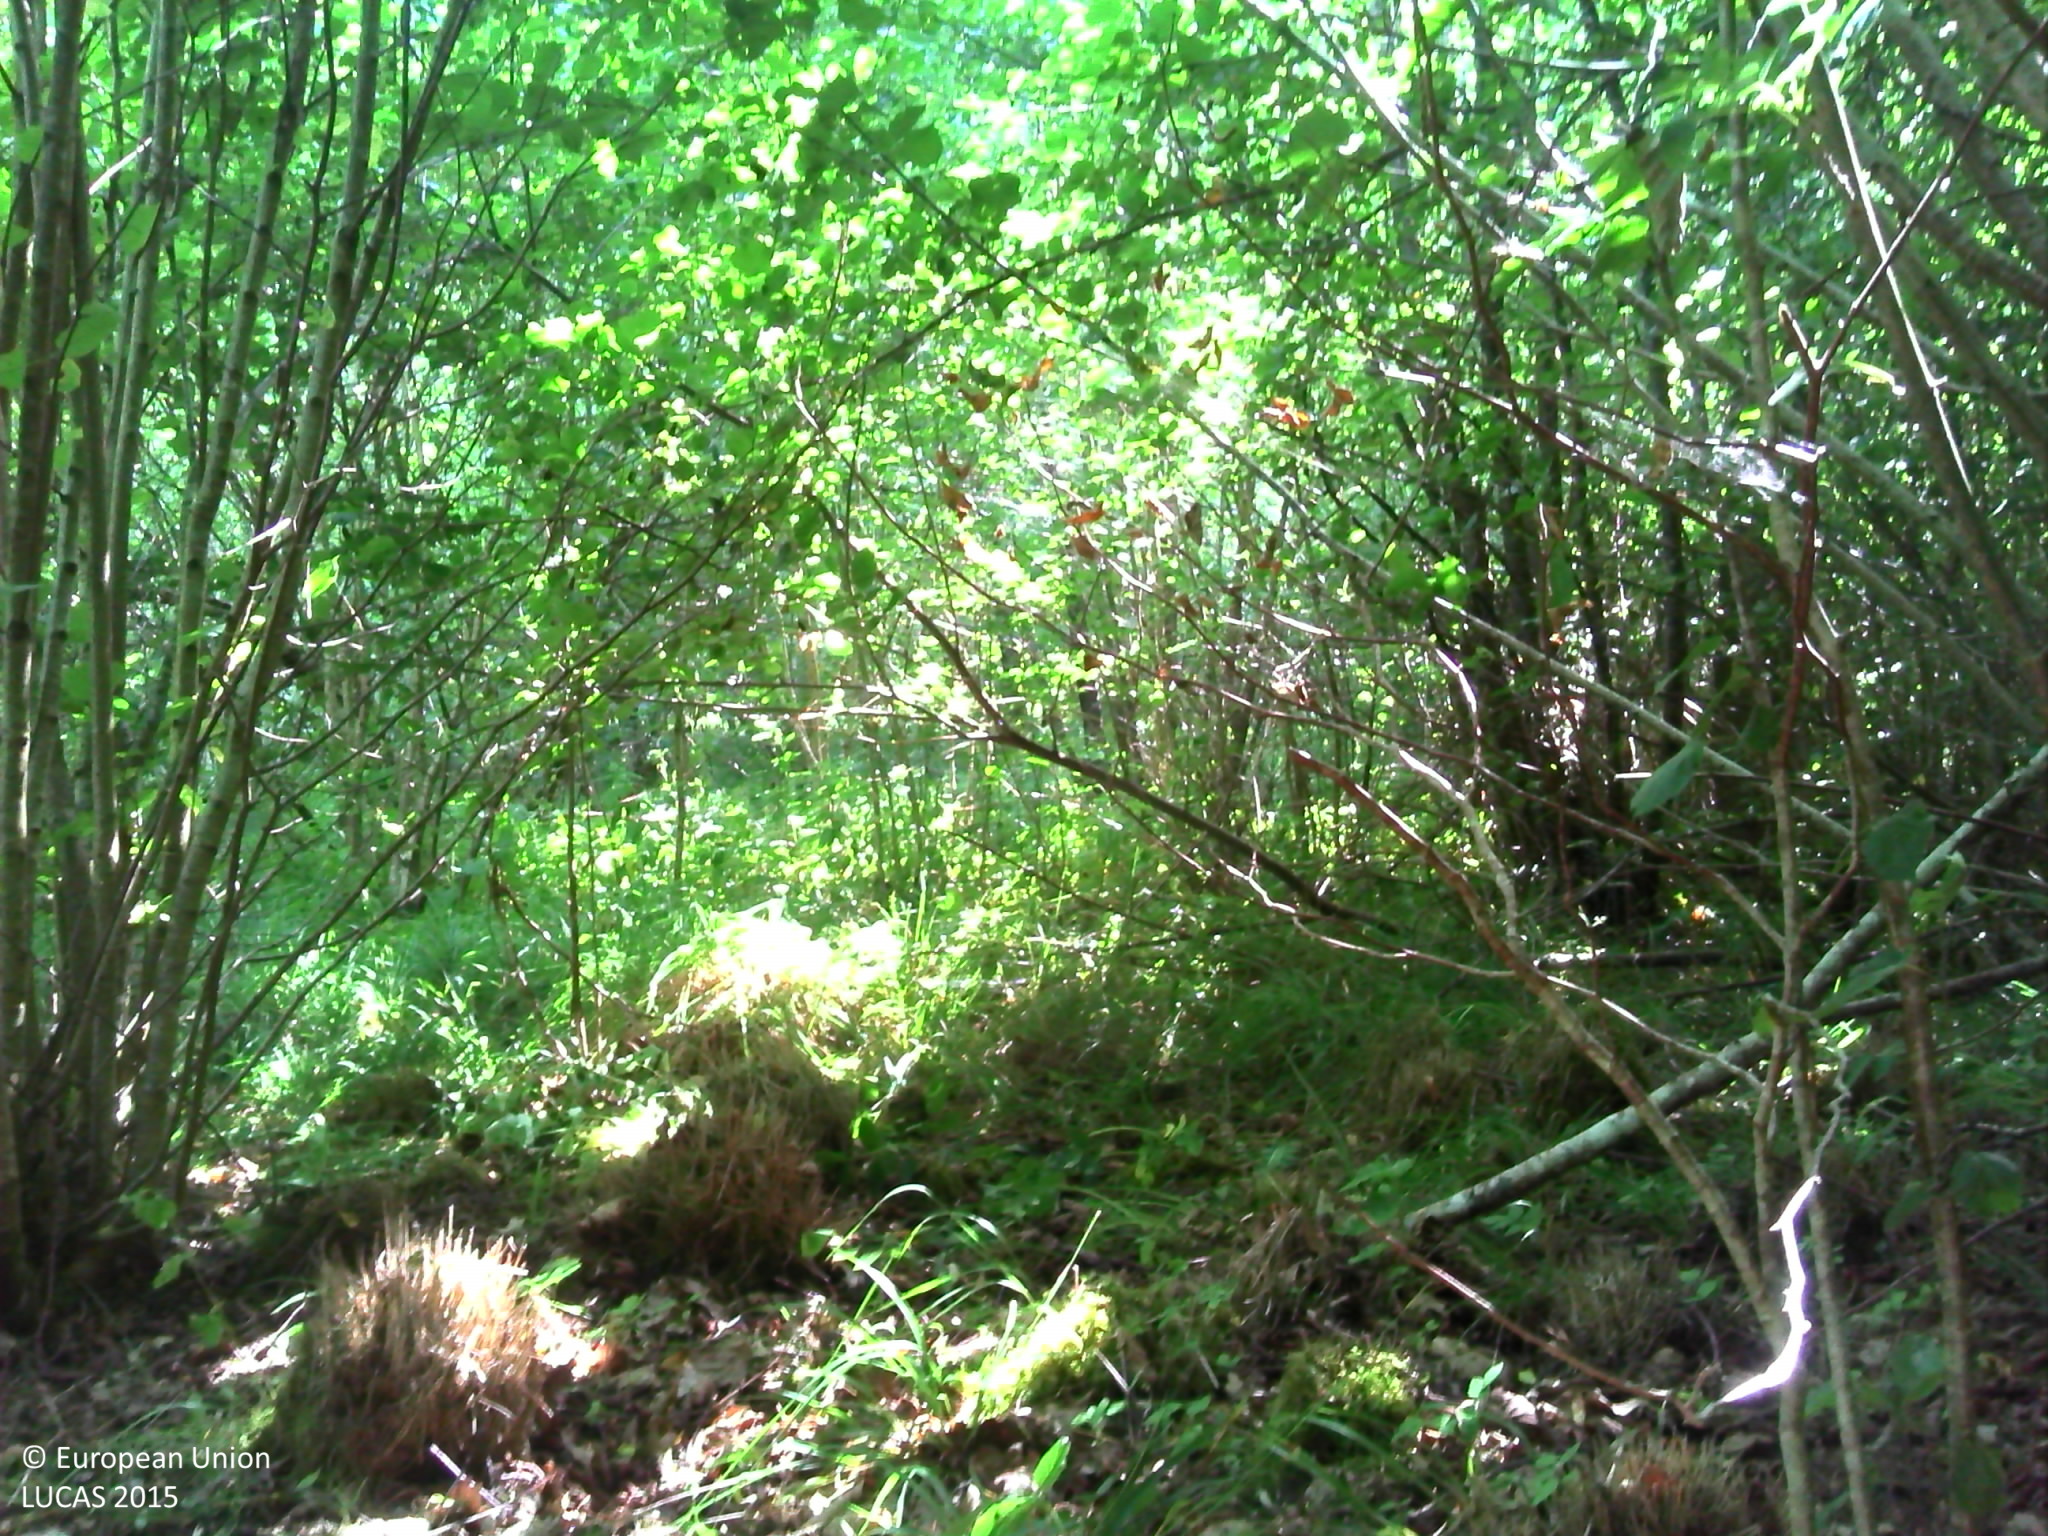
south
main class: Woodland
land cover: Broadleaved woodland
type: mesophytic deciduous forest
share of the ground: > 75 %
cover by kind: broadleaved forest trees 100 %
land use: Forestry
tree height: > 5 m
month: July
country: FR
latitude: 43.6321
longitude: 2.5823
